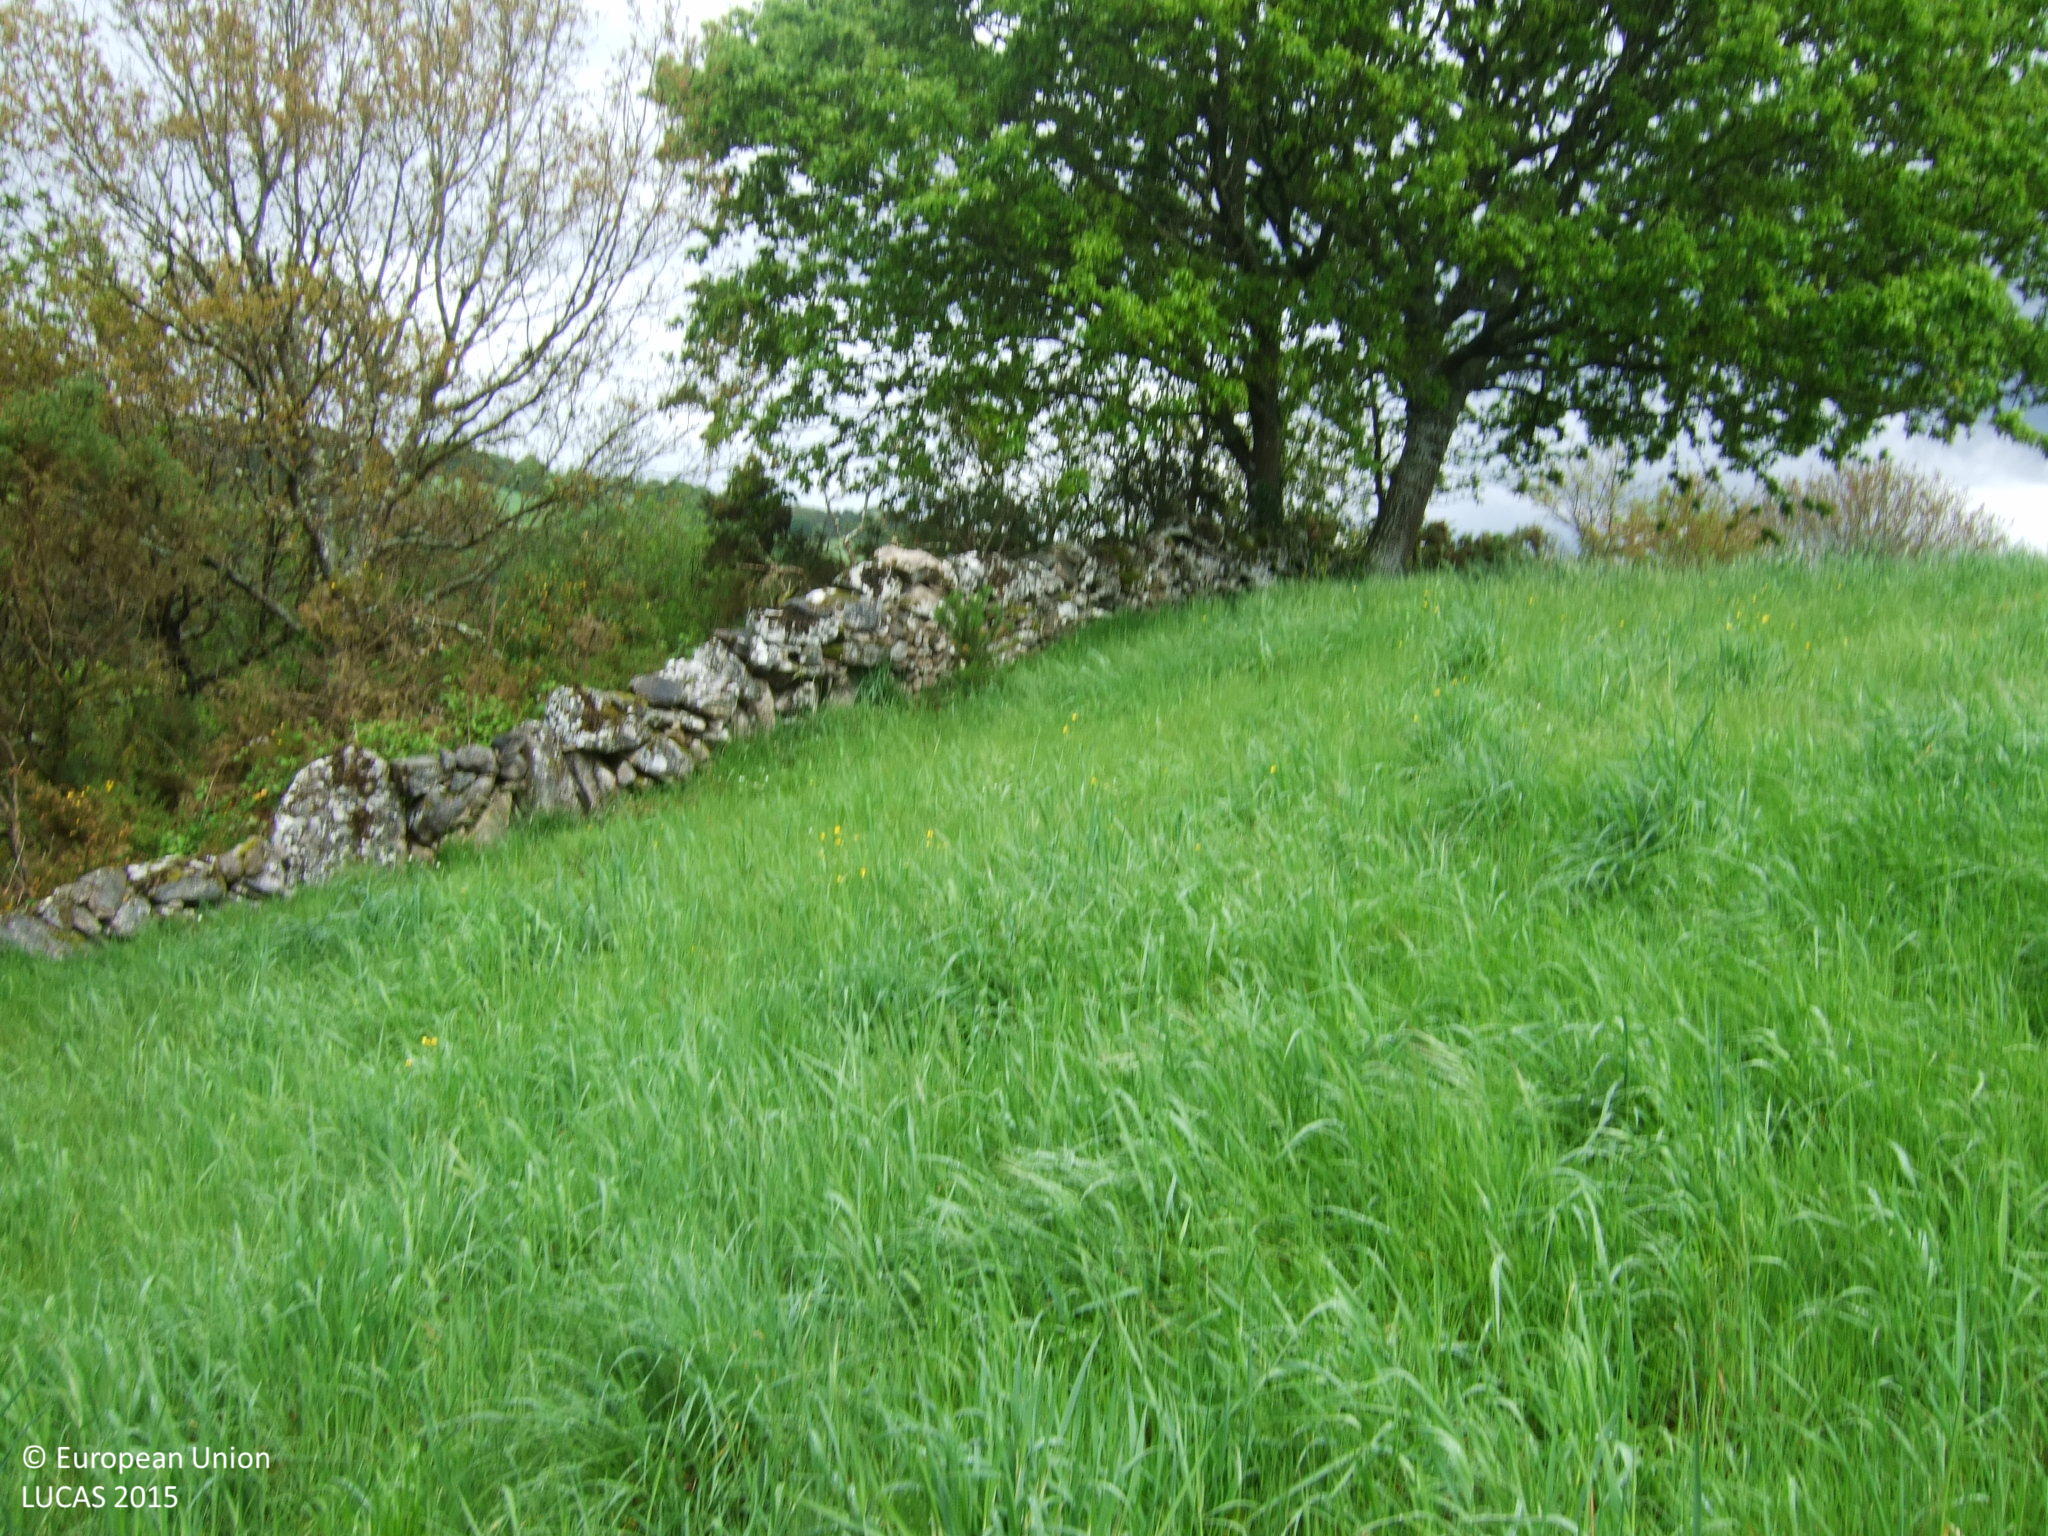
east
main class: Grassland
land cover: Grassland without tree/shrub cover
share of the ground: > 75 %
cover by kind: herbaceous plants 100 %
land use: Agriculture (excluding fallow land and kitchen gardens)
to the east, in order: Grassland without tree/shrub cover; Dry stone walls; Broadleaved woodland; Dry stone walls; Grassland without tree/shrub cover; Tracks; Dry stone walls; Broadleaved woodland; Dry stone walls; Broadleaved woodland; Dry stone walls; Broadleaved woodland; Dry stone walls; Broadleaved woodland
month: May
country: ES
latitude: 42.7689
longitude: -7.5375
